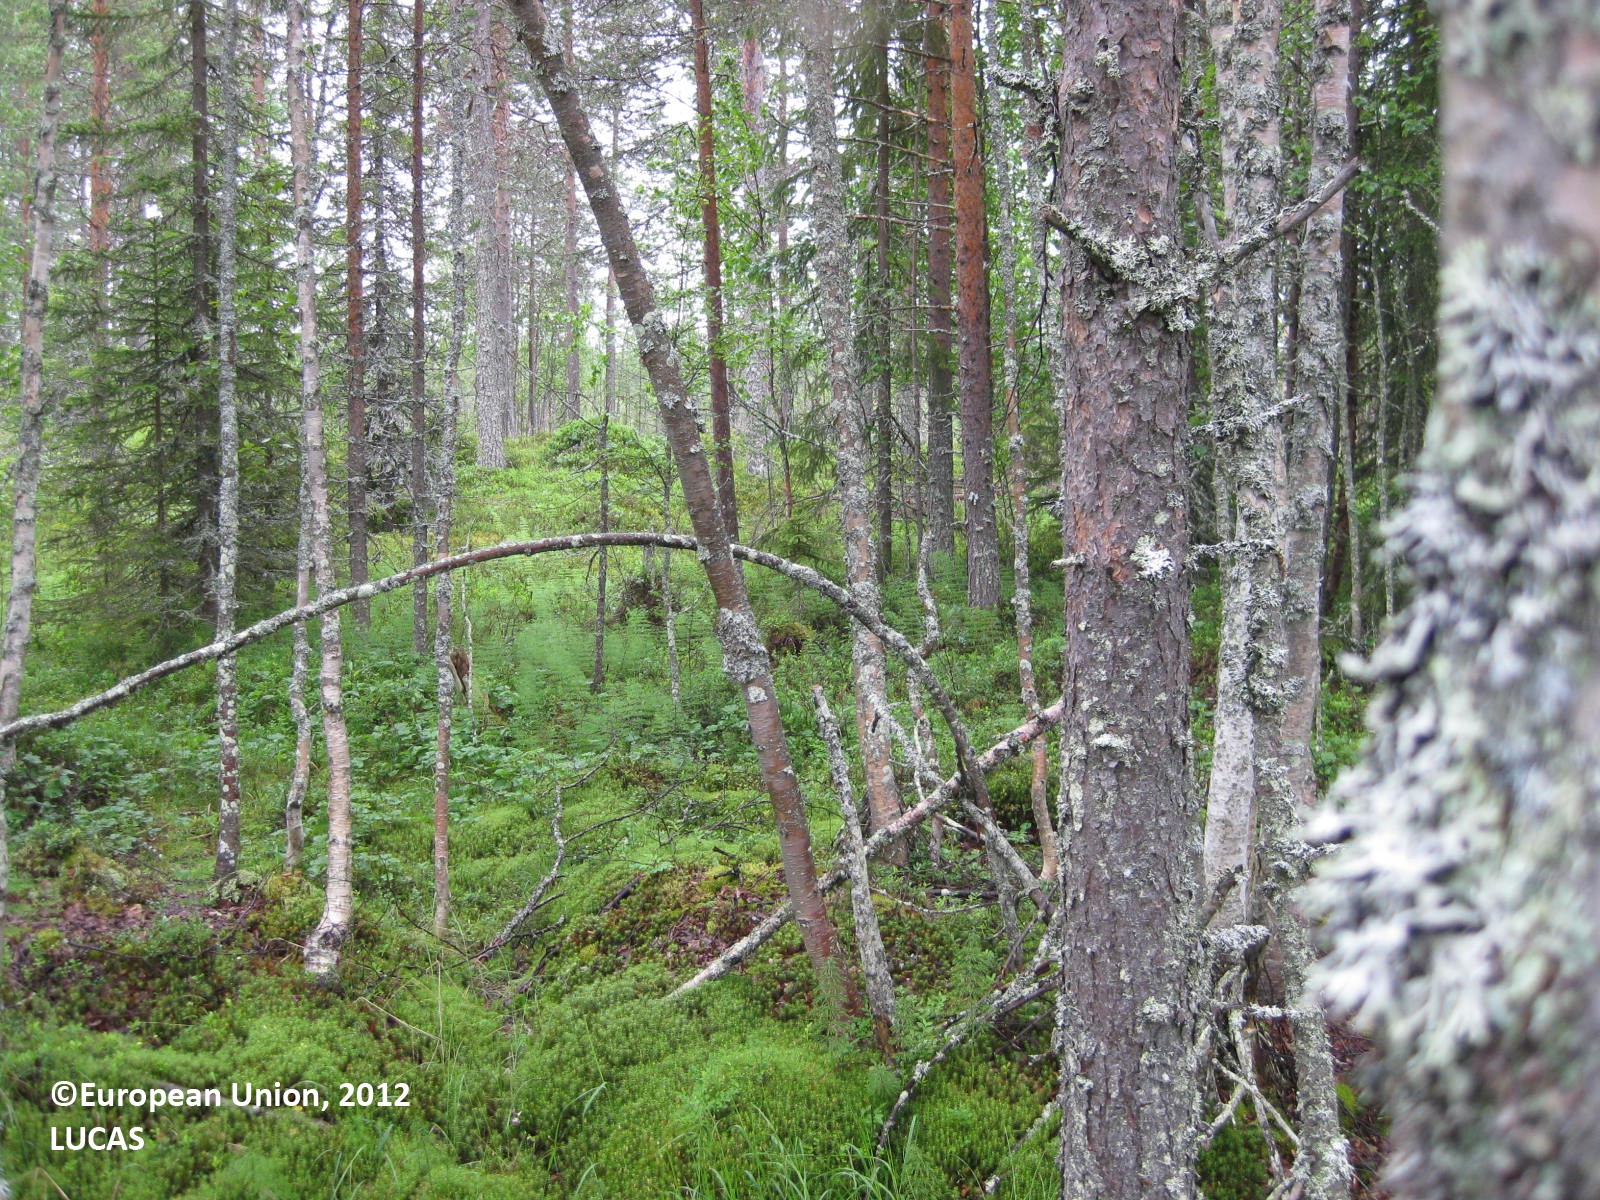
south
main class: Woodland
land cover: Broadleaved woodland
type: boreal forest
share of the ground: > 75 %
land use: Forestry
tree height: > 5 m
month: July
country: FI
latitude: 65.8140
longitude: 29.9644
